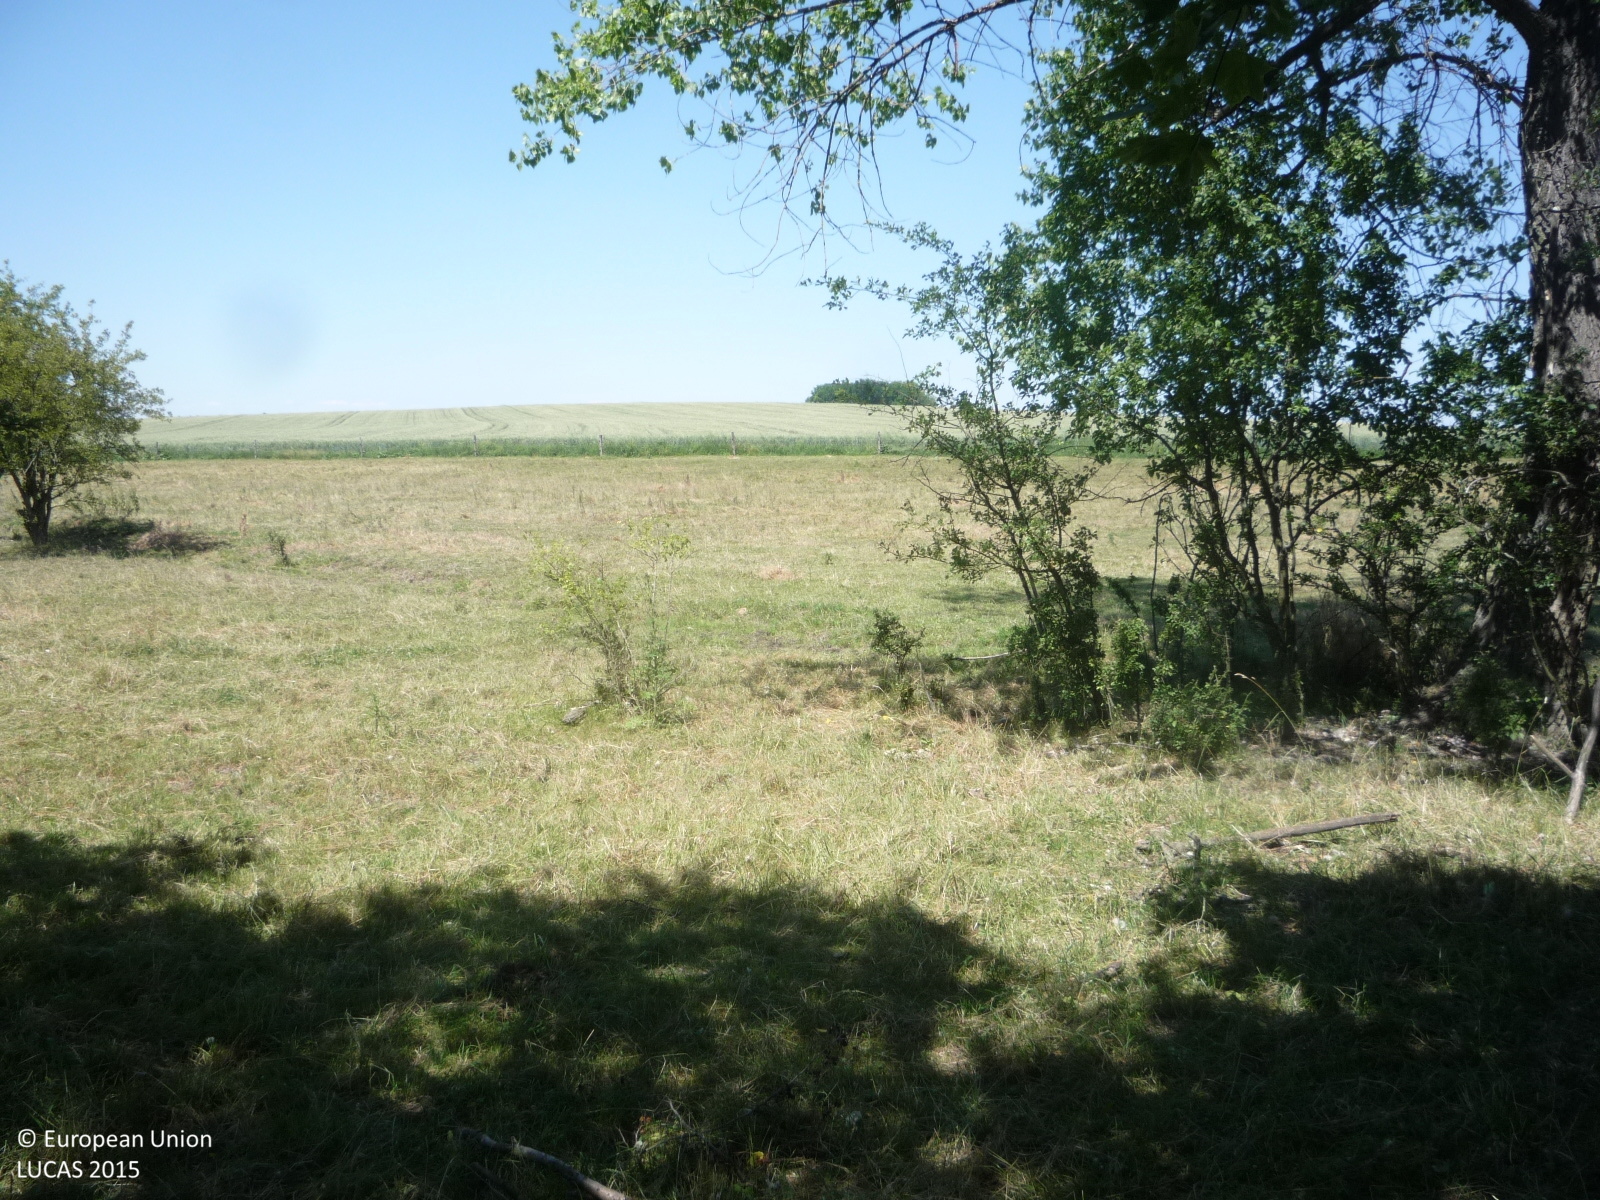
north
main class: Grassland
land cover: Grassland without tree/shrub cover
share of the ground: > 75 %
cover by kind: herbaceous plants 100 %
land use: Agriculture (excluding fallow land and kitchen gardens)
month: July
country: CZ
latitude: 50.2789
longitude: 15.2657
